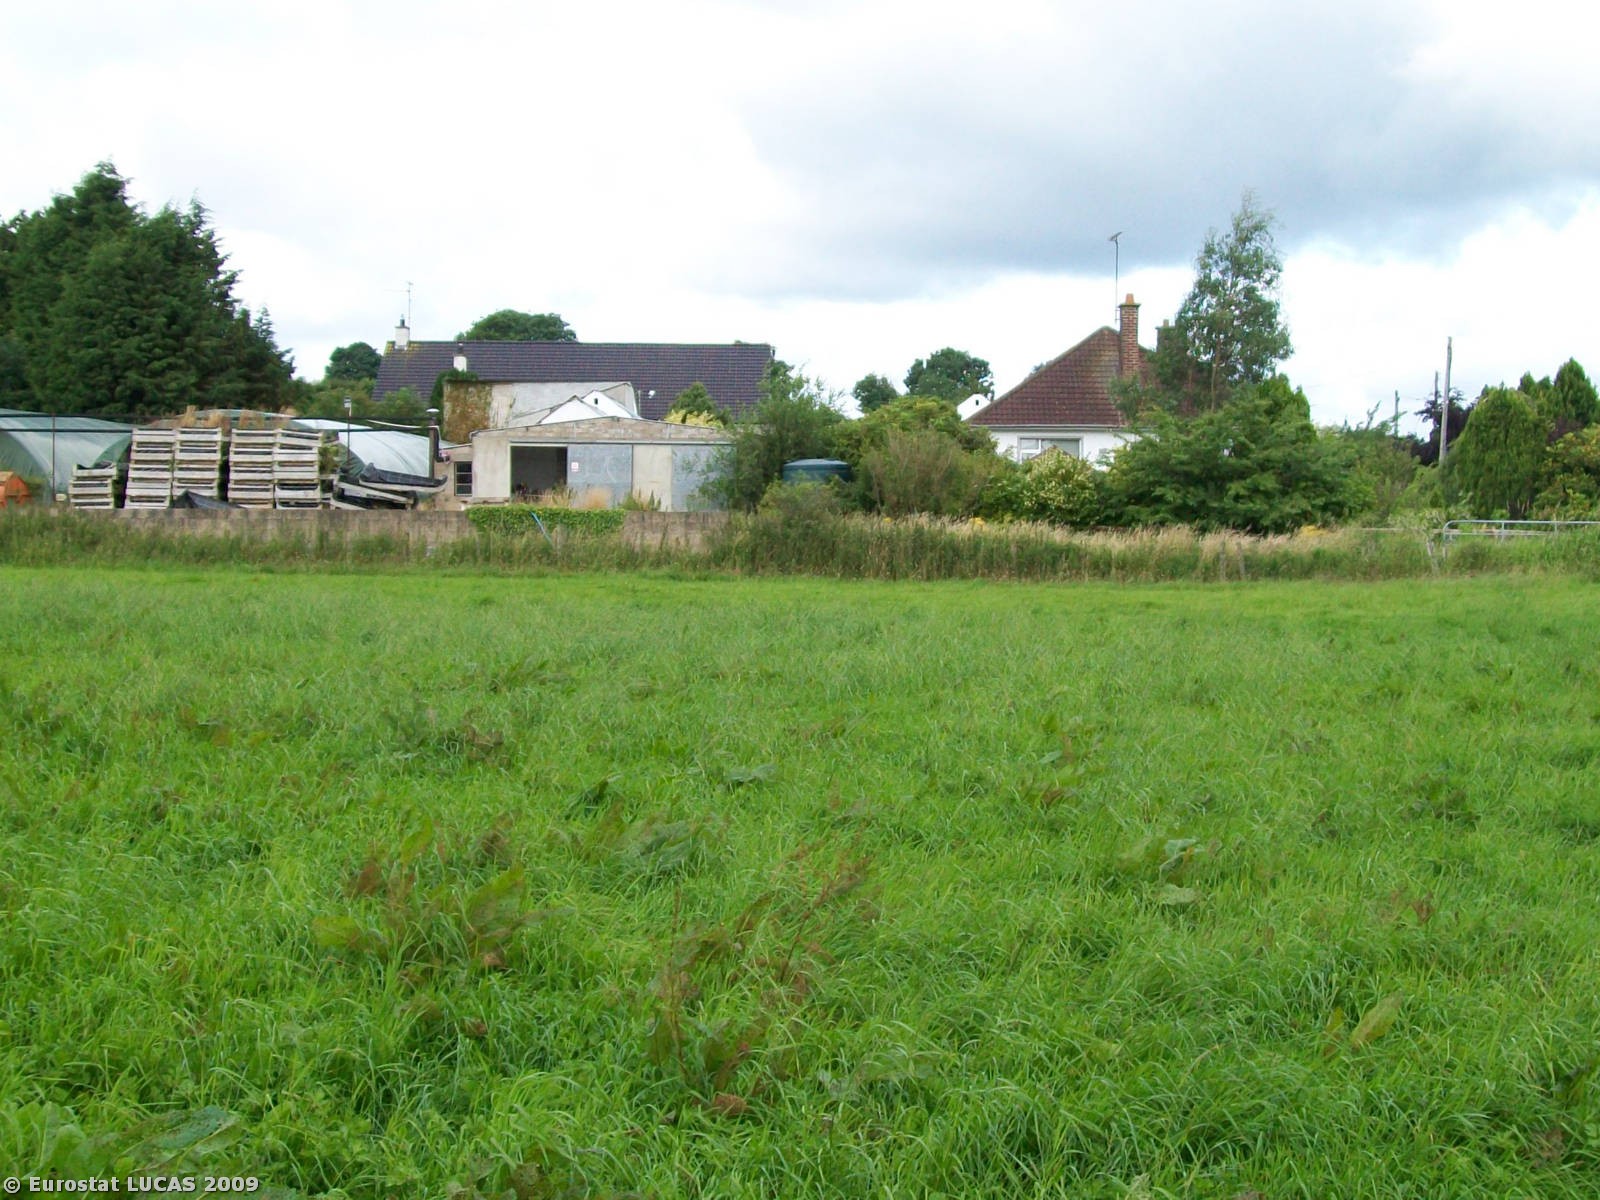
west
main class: Grassland
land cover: Grassland without tree/shrub cover
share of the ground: > 75 %
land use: Agriculture (excluding fallow land and kitchen gardens)
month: July
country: GB
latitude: 54.6272
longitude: -6.6559
